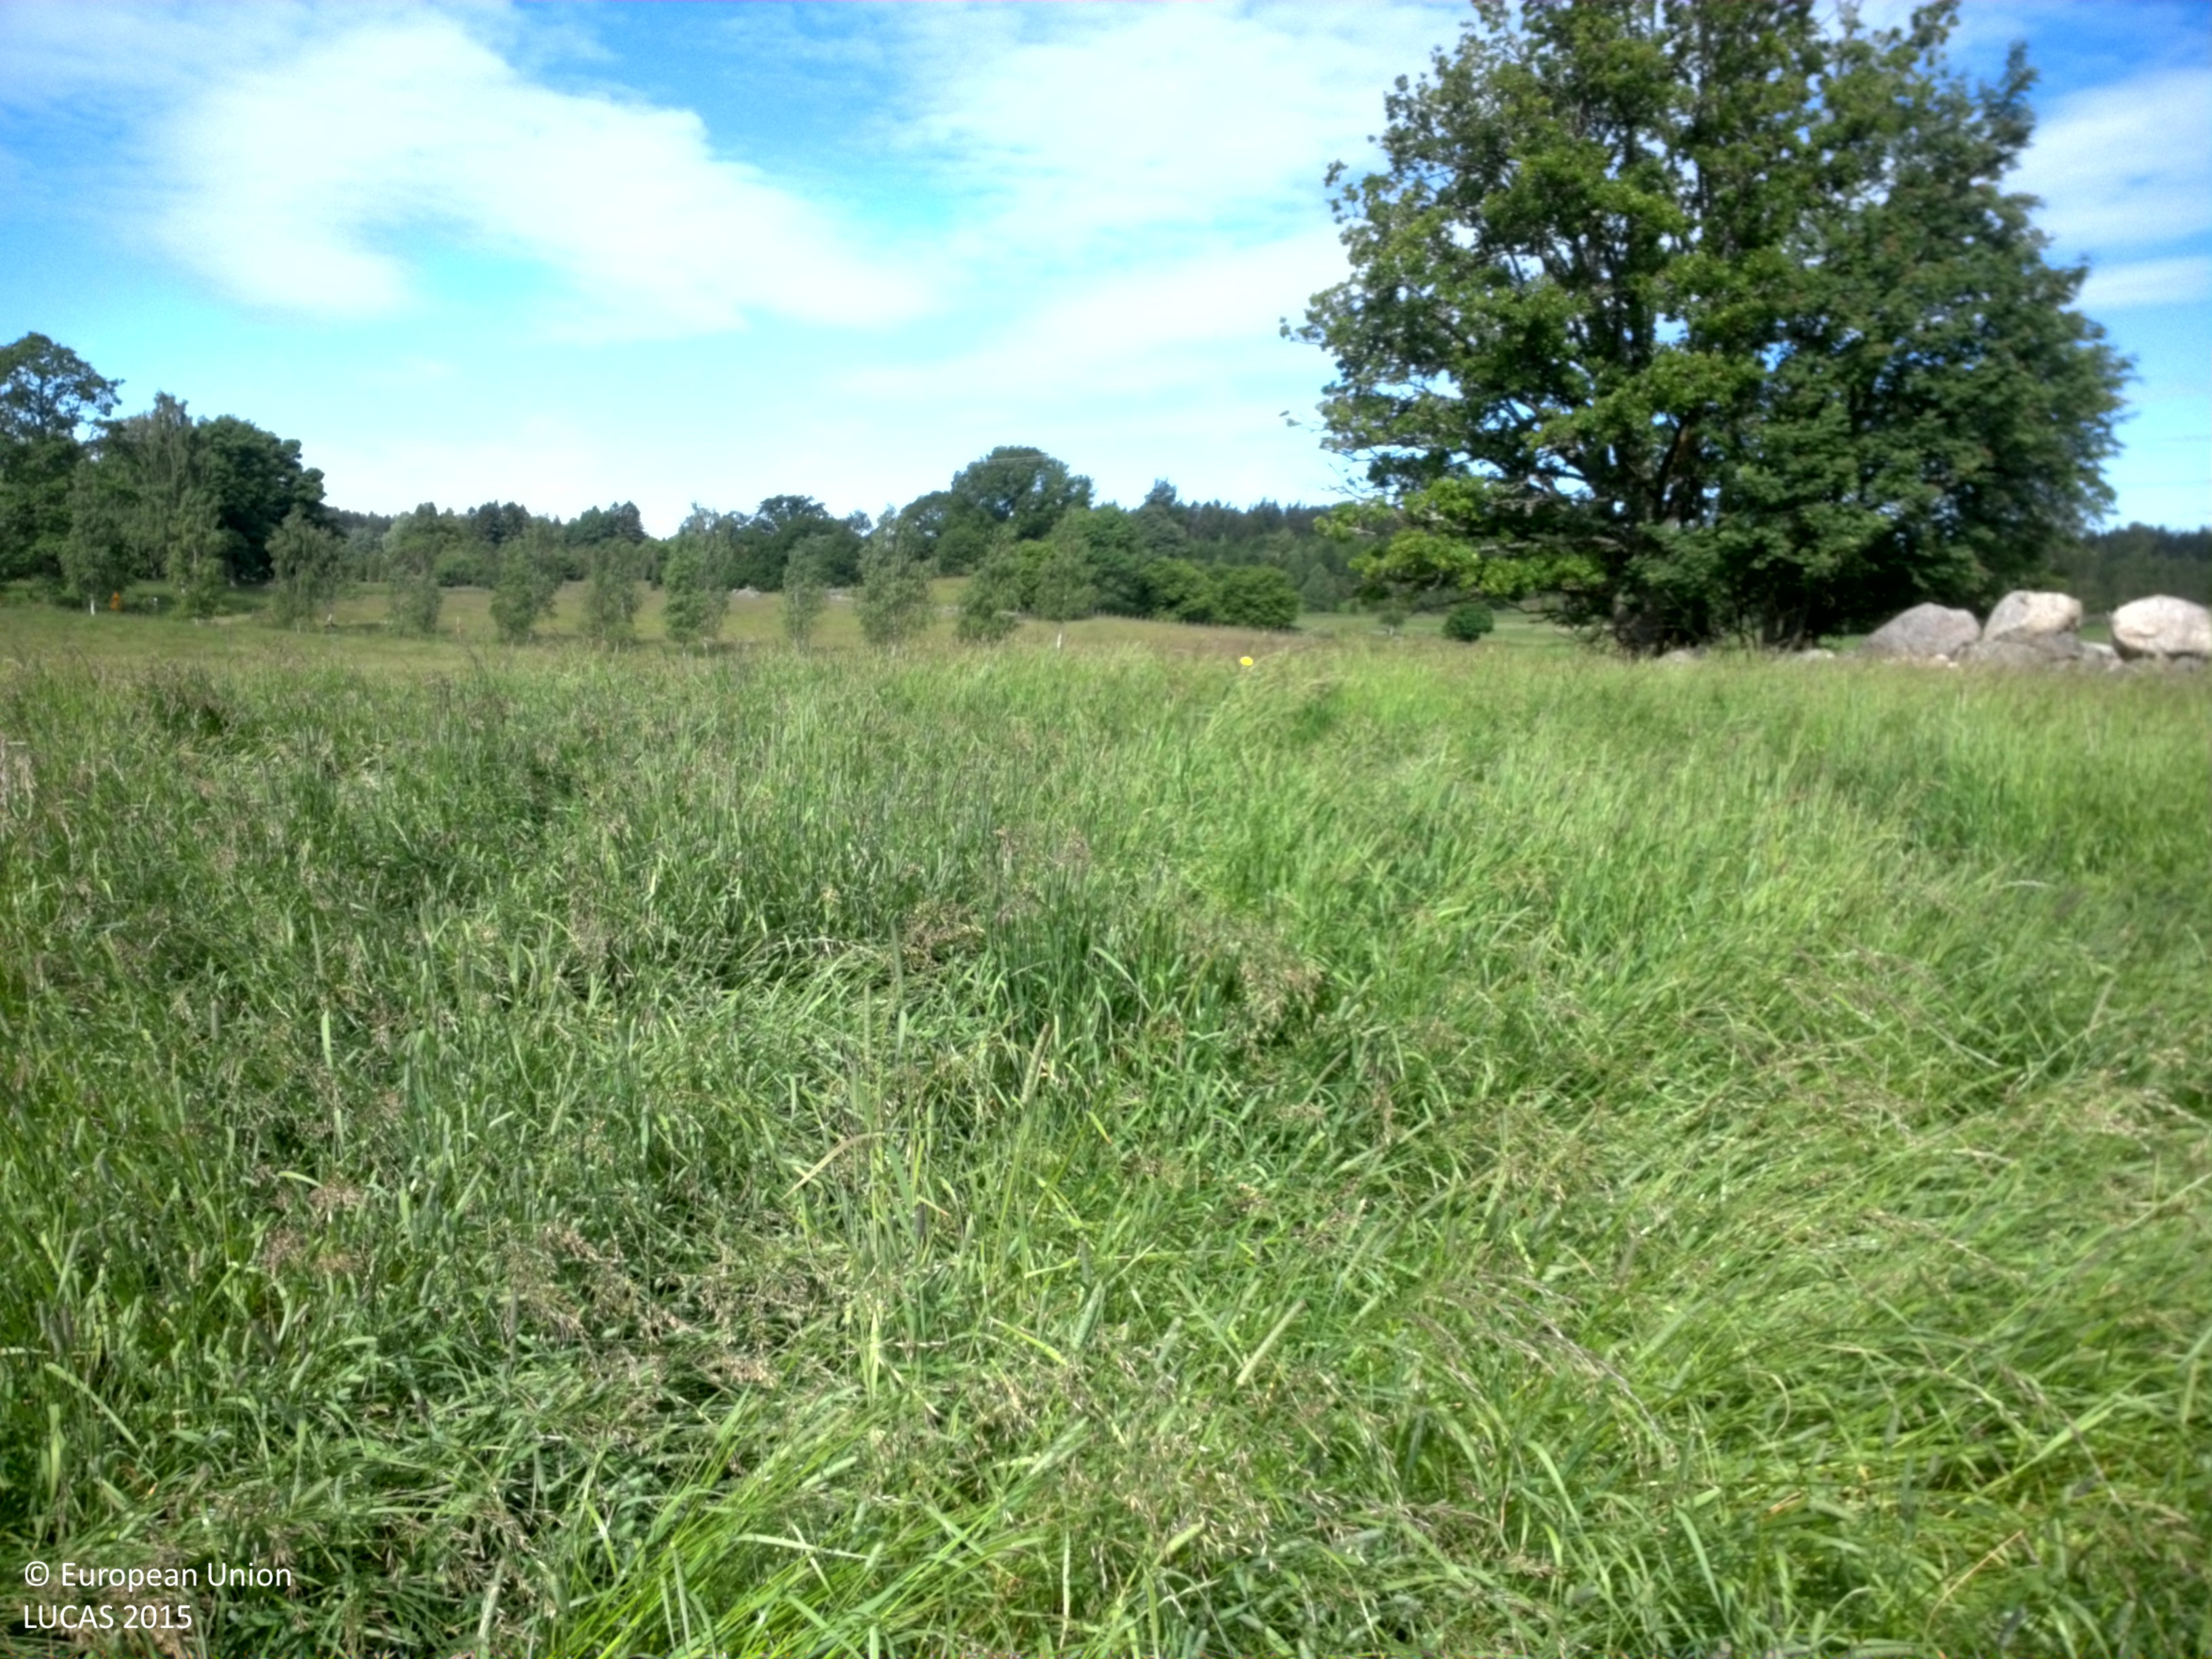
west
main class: Cropland
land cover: Temporary grasslands
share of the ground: > 75 %
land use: Agriculture (excluding fallow land and kitchen gardens)
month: June
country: SE
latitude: 58.5395
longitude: 15.5084
